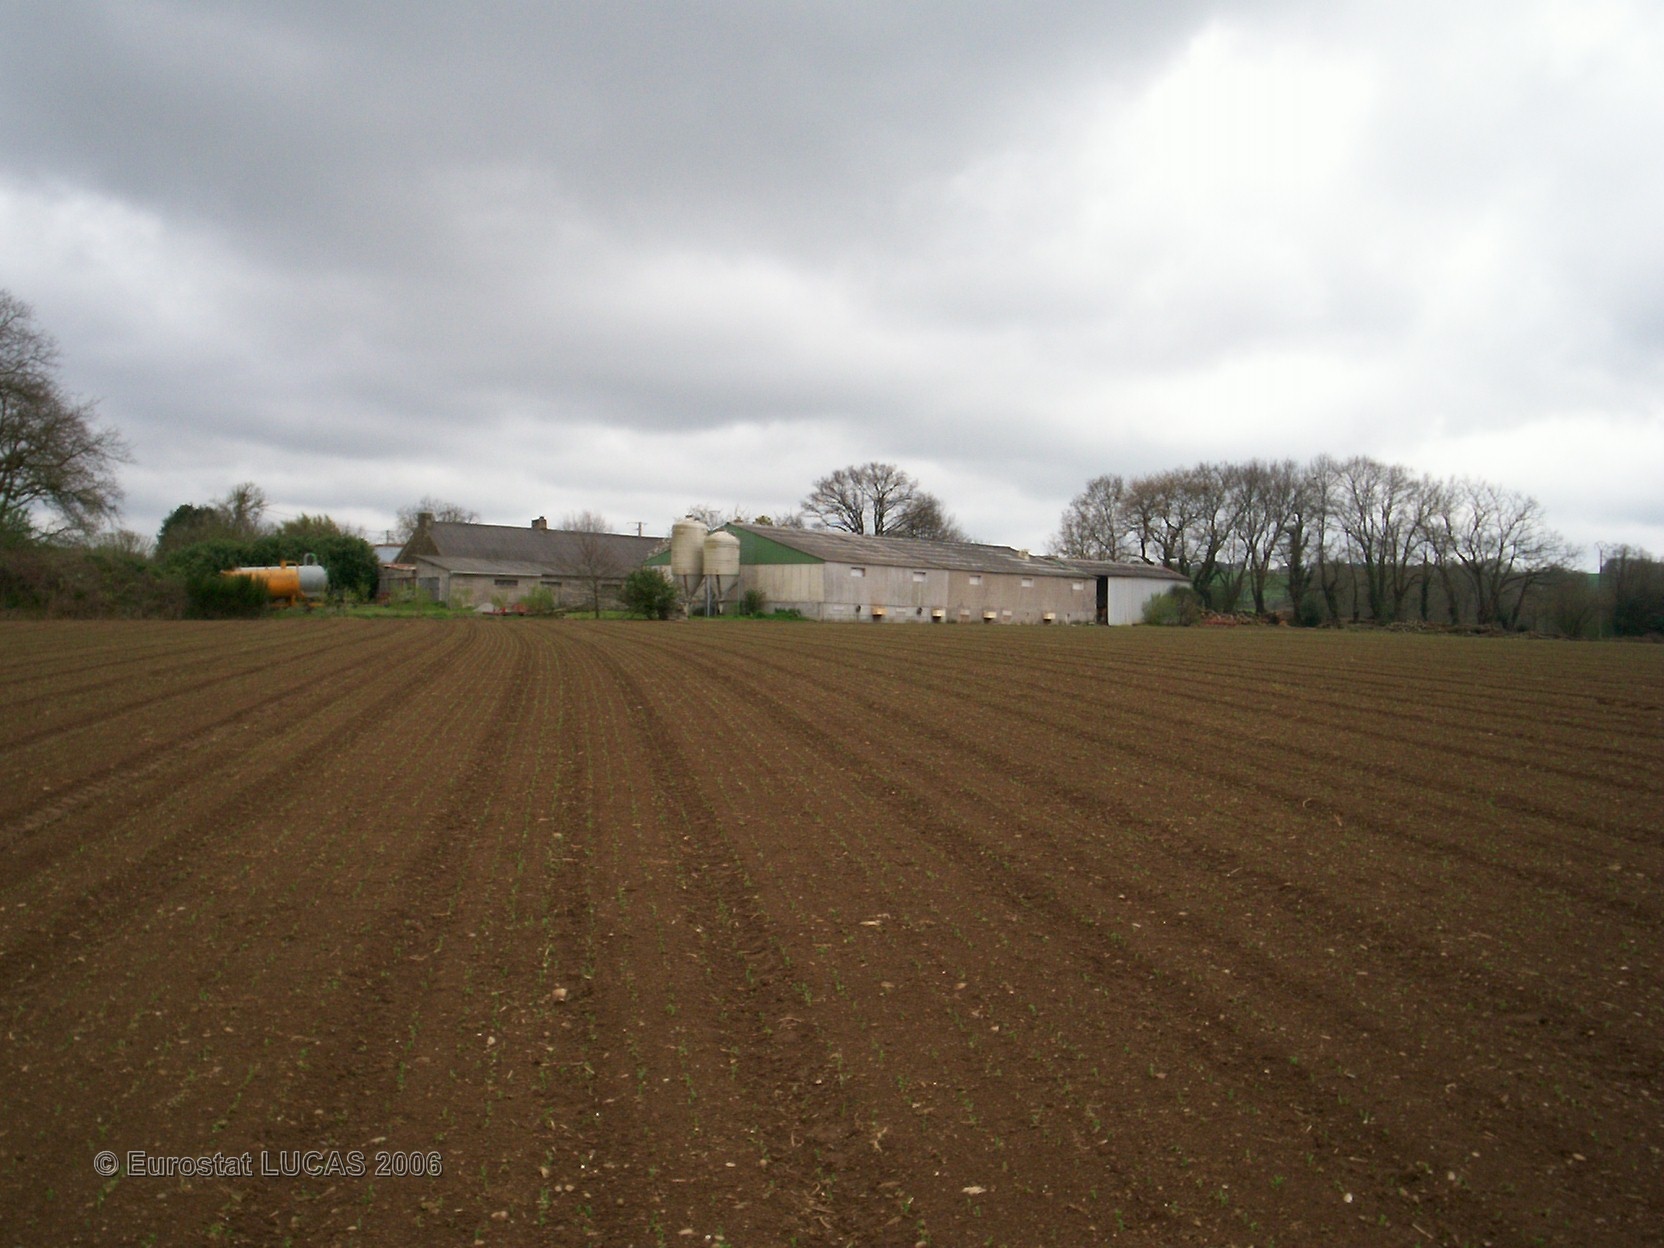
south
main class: Cropland
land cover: Other fresh vegetables
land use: Agriculture (excluding fallow land and kitchen gardens)
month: April
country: FR
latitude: 47.7760
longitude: -2.8622
